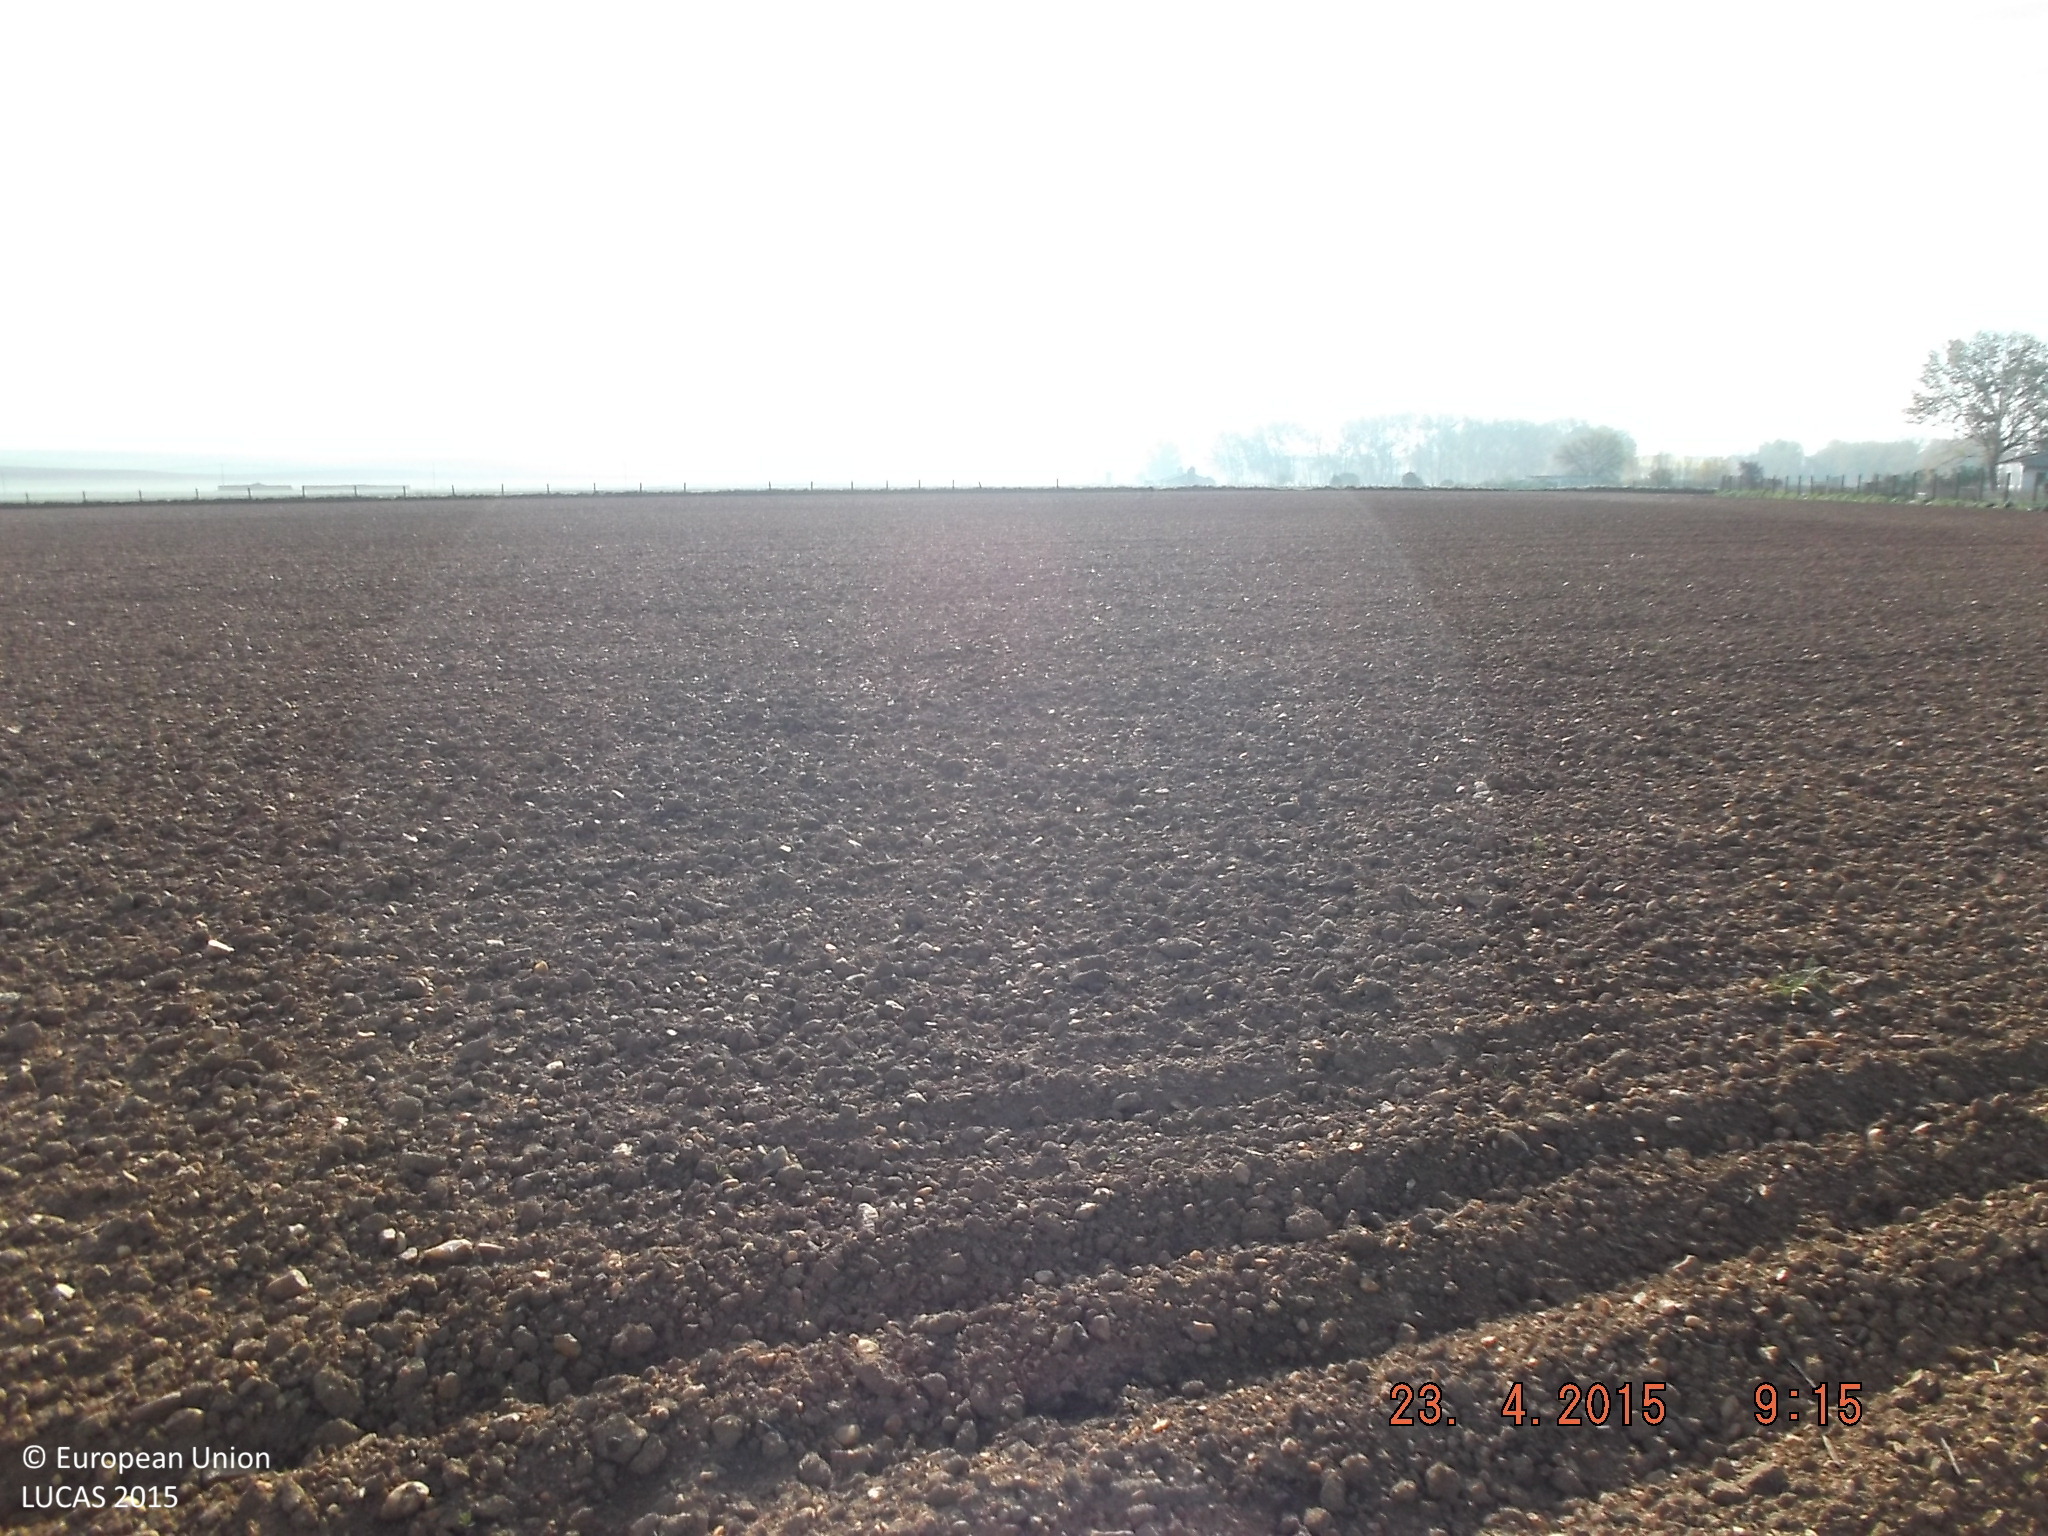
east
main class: Cropland
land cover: Common wheat
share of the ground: > 75 %
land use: Agriculture (excluding fallow land and kitchen gardens)
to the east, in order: Common wheat; Other bare soil; Fences; Grass margins; Common wheat
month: April
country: ES
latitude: 40.9135
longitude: -5.8838
